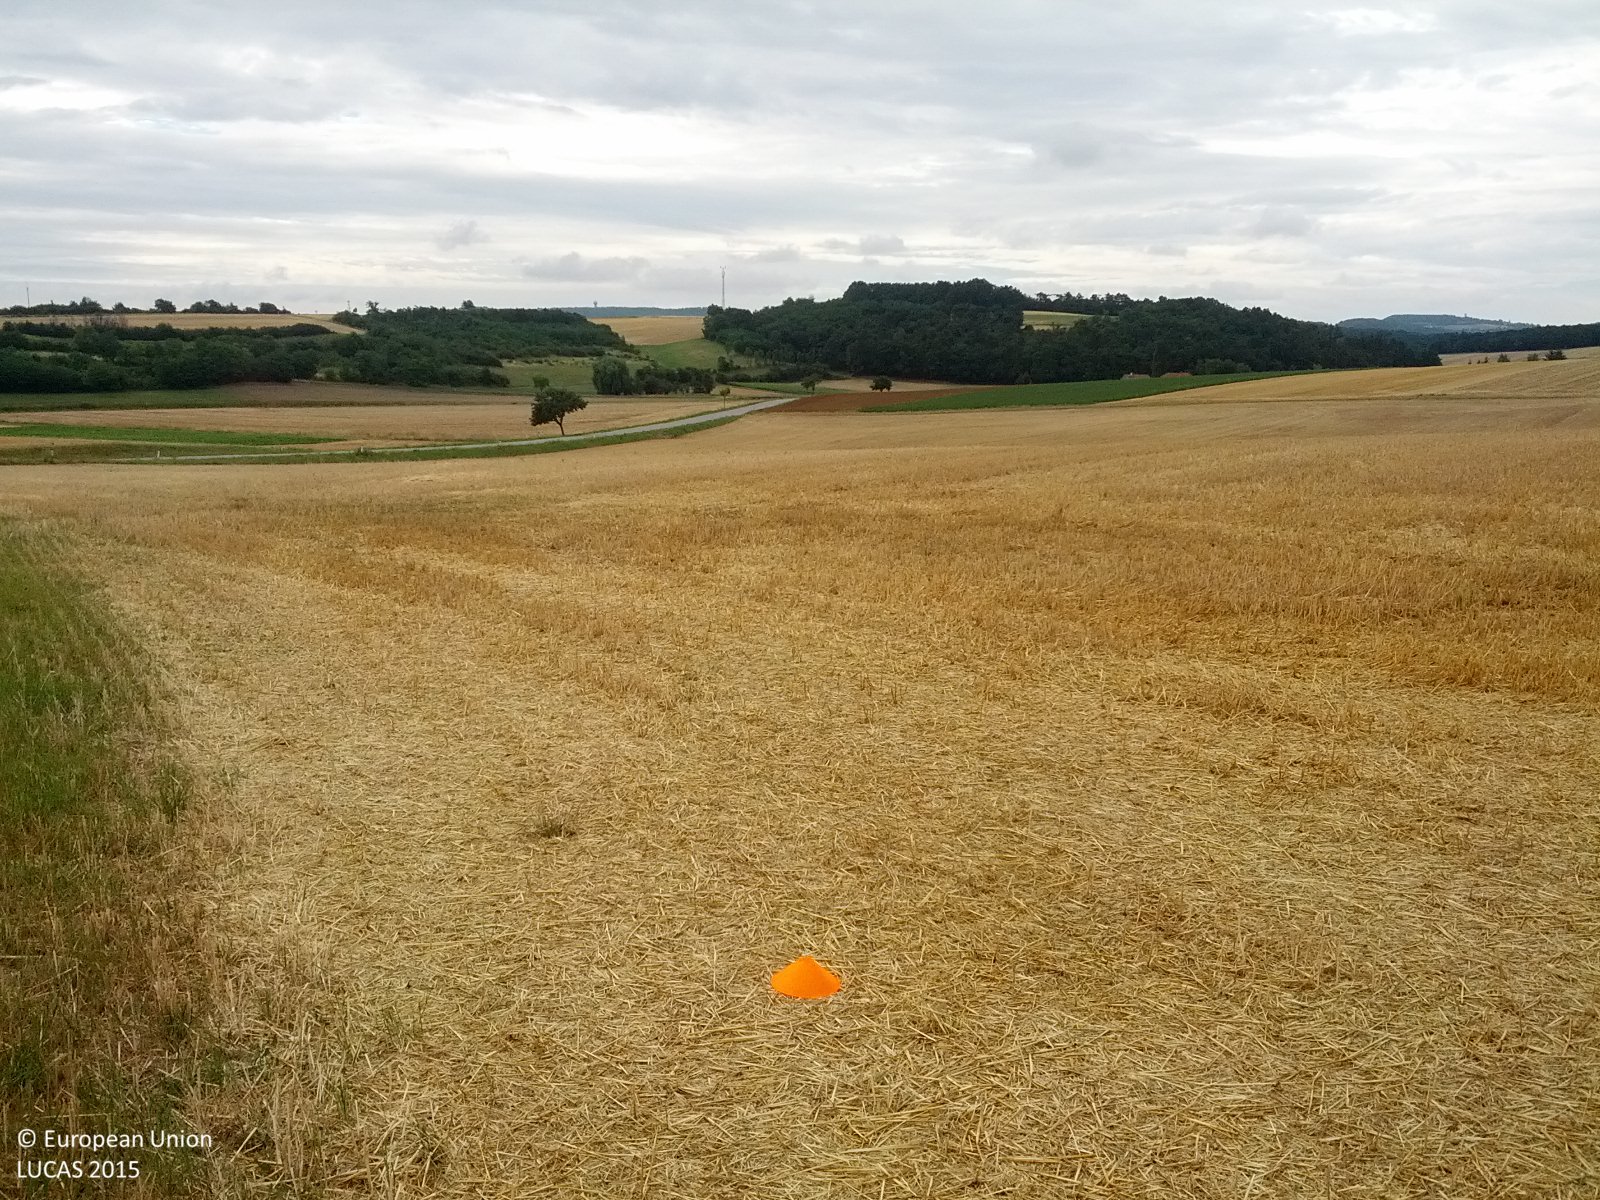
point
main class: Cropland
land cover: Common wheat
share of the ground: 10 - 25 %
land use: Agriculture (excluding fallow land and kitchen gardens)
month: July
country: AT
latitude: 48.6185
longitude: 16.3406
